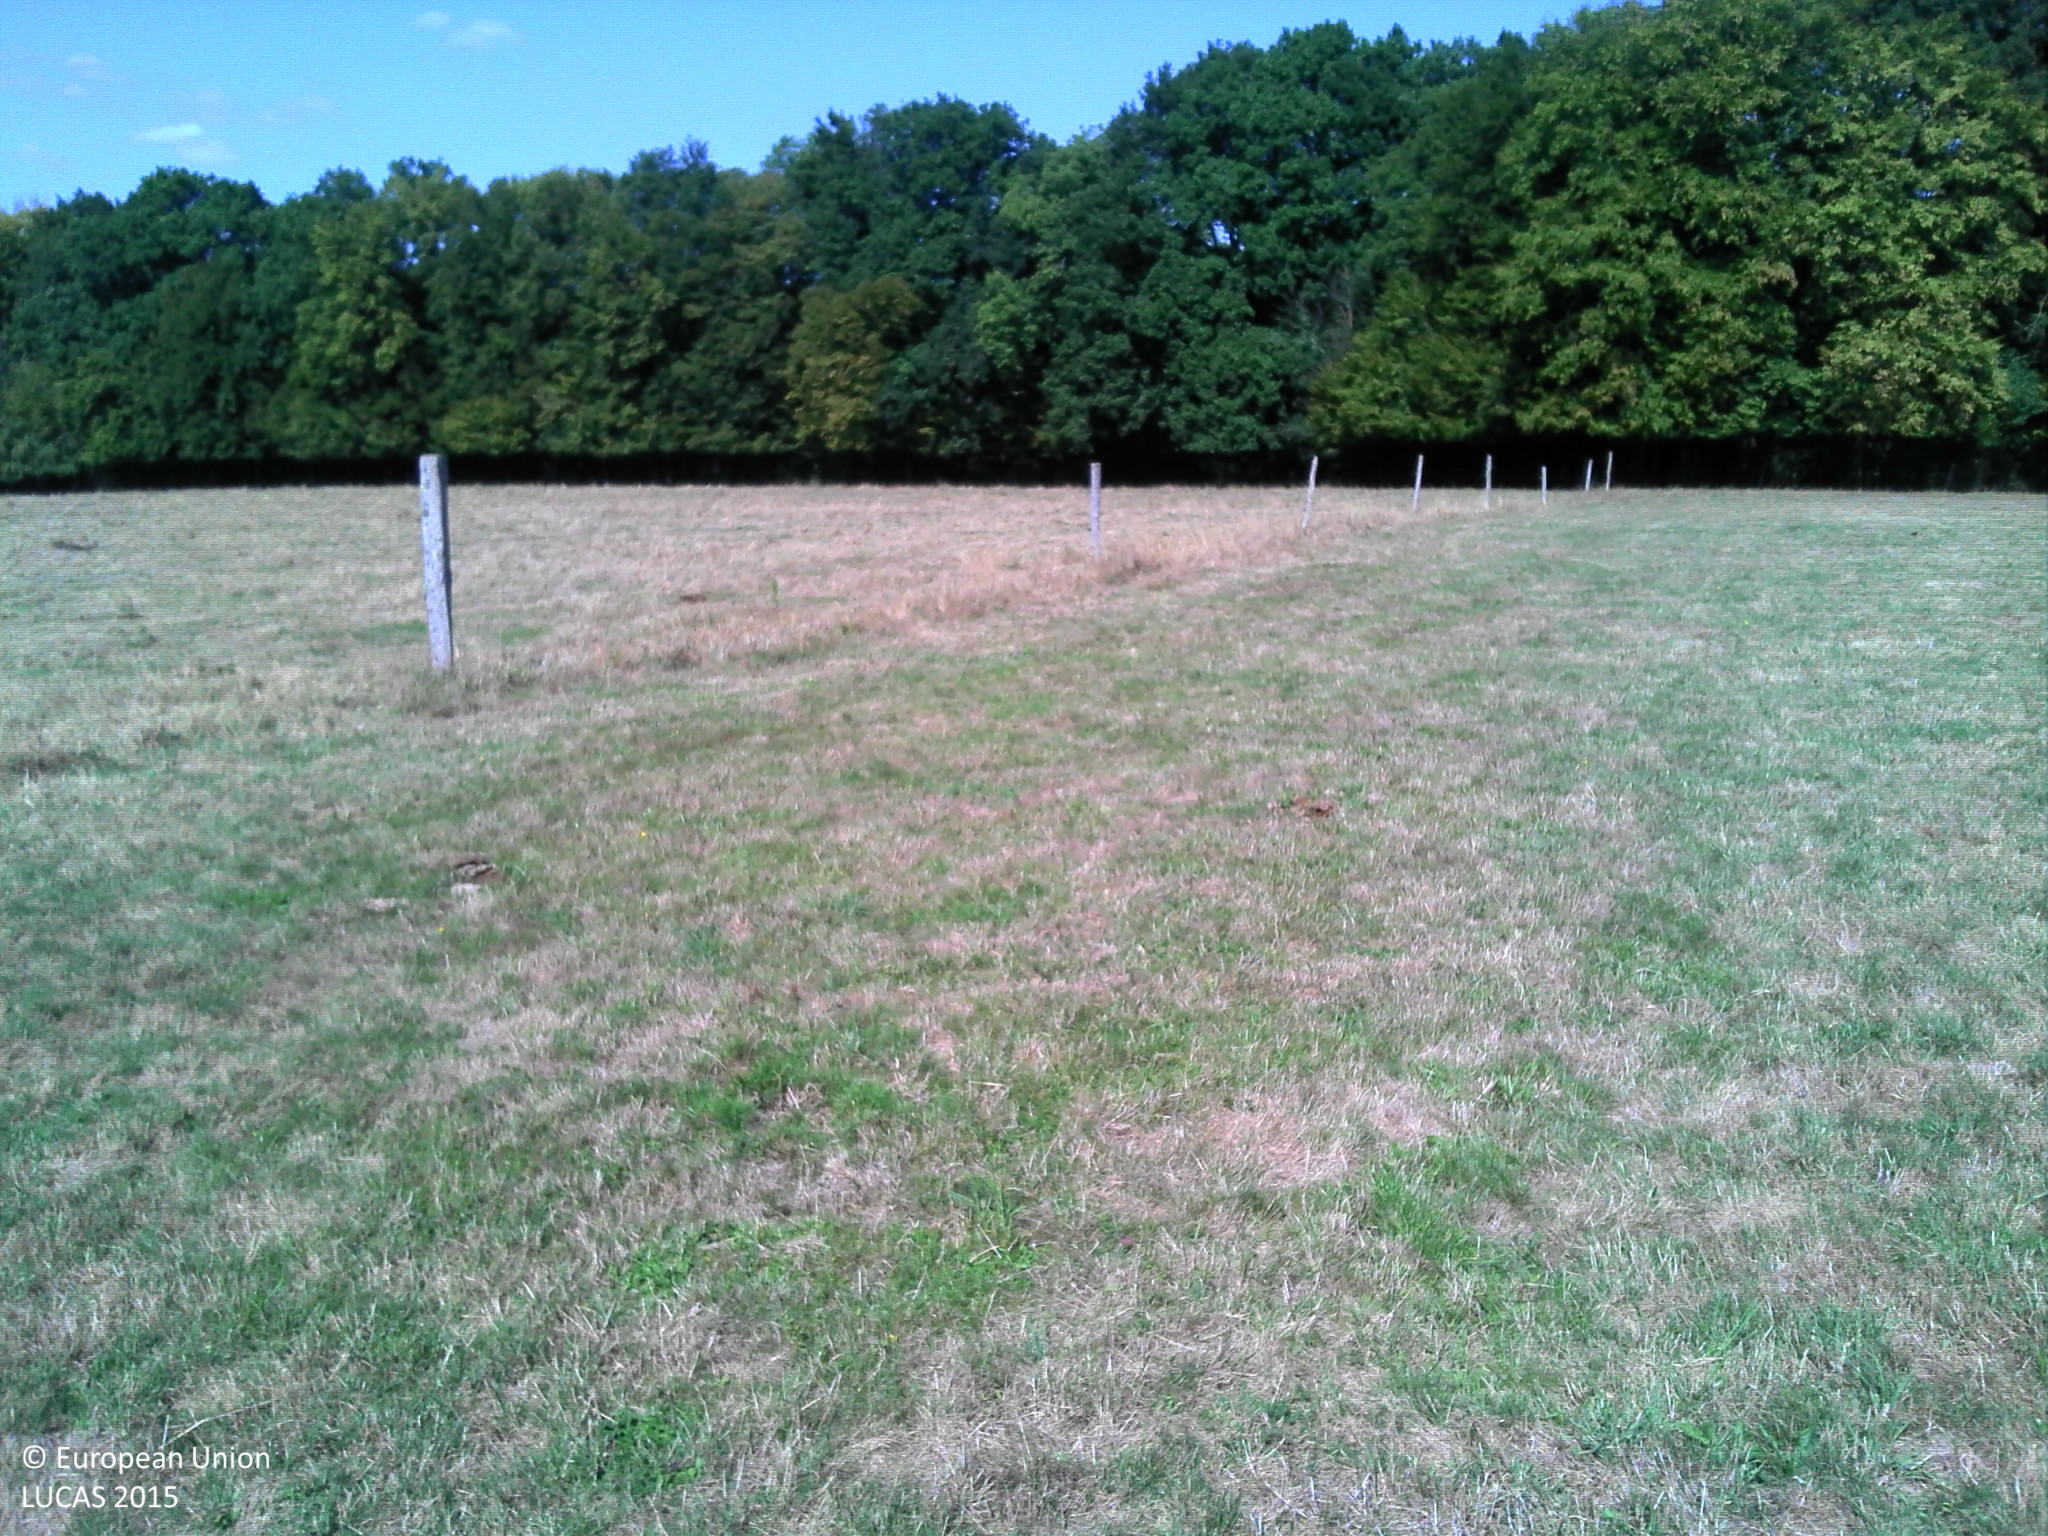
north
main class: Grassland
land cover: Grassland without tree/shrub cover
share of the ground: > 75 %
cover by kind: herbaceous plants 85 %, consolidated bare surface 15 %
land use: Agriculture (excluding fallow land and kitchen gardens)
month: September
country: FR
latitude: 48.6562
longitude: 6.0222
